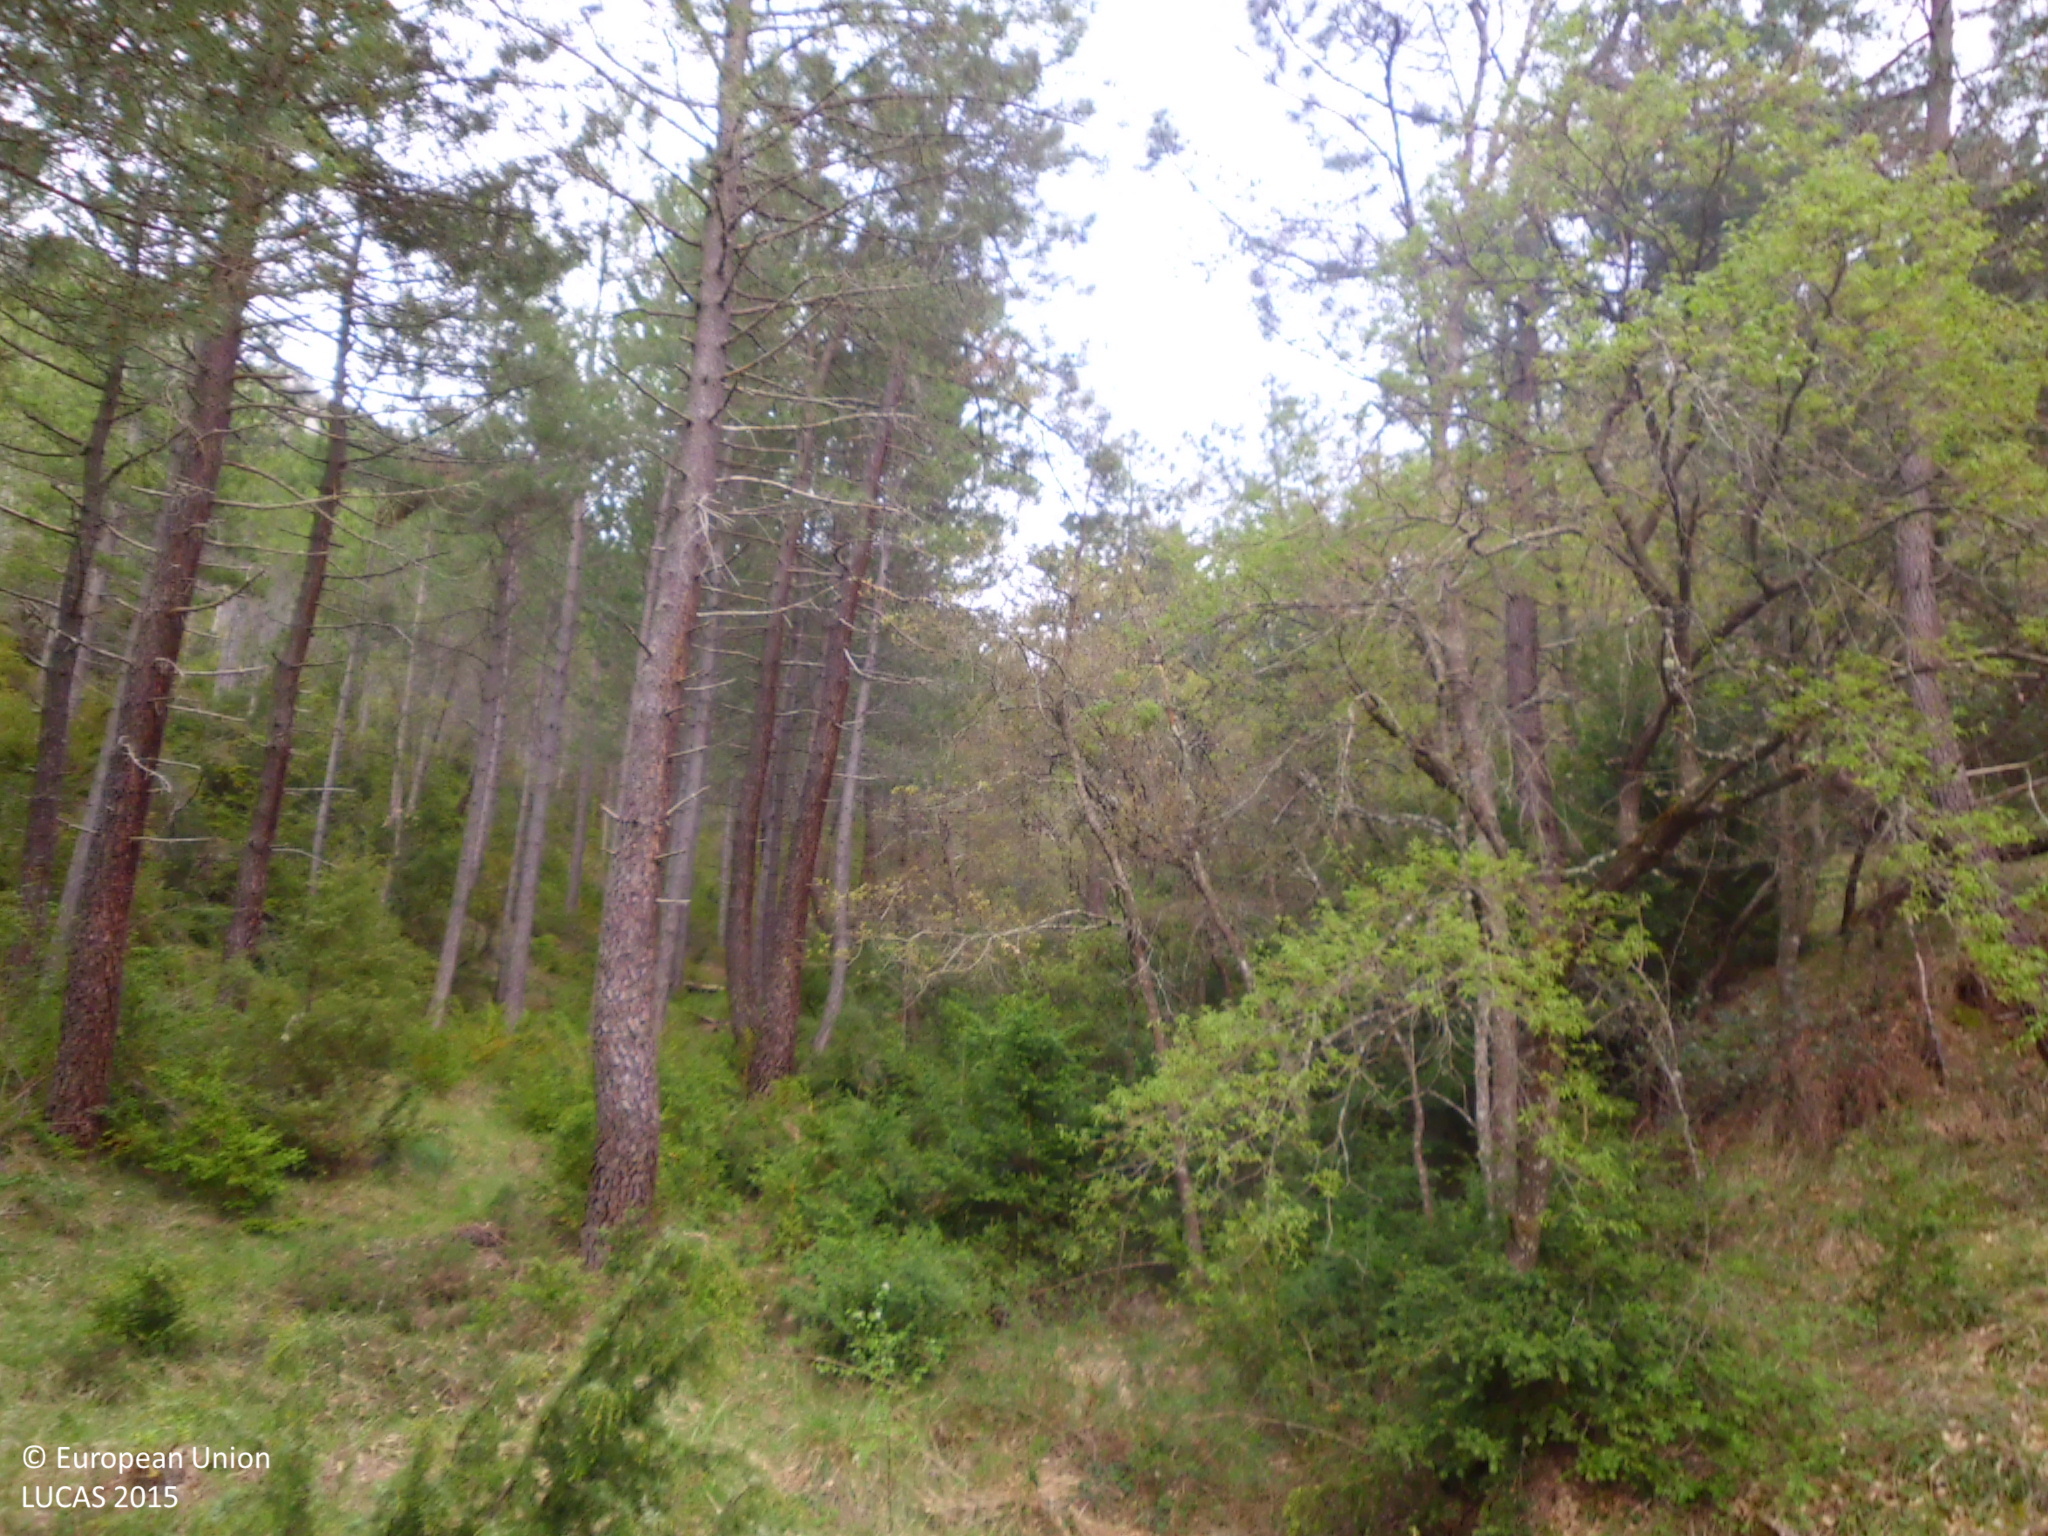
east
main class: Woodland
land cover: Pine dominated mixed woodland
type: coniferous forest of the mediterranean region
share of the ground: > 75 %
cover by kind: coniferous forest trees 55 %, broadleaved forest trees 20 %, shrubs 15 %, herbaceous plants 10 %
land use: Semi-natural and natural areas not in use
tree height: > 5 m
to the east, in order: Pine dominated mixed woodland; Rock outcrops; Pine dominated mixed woodland
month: April
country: ES
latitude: 42.7945
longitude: -3.4491
